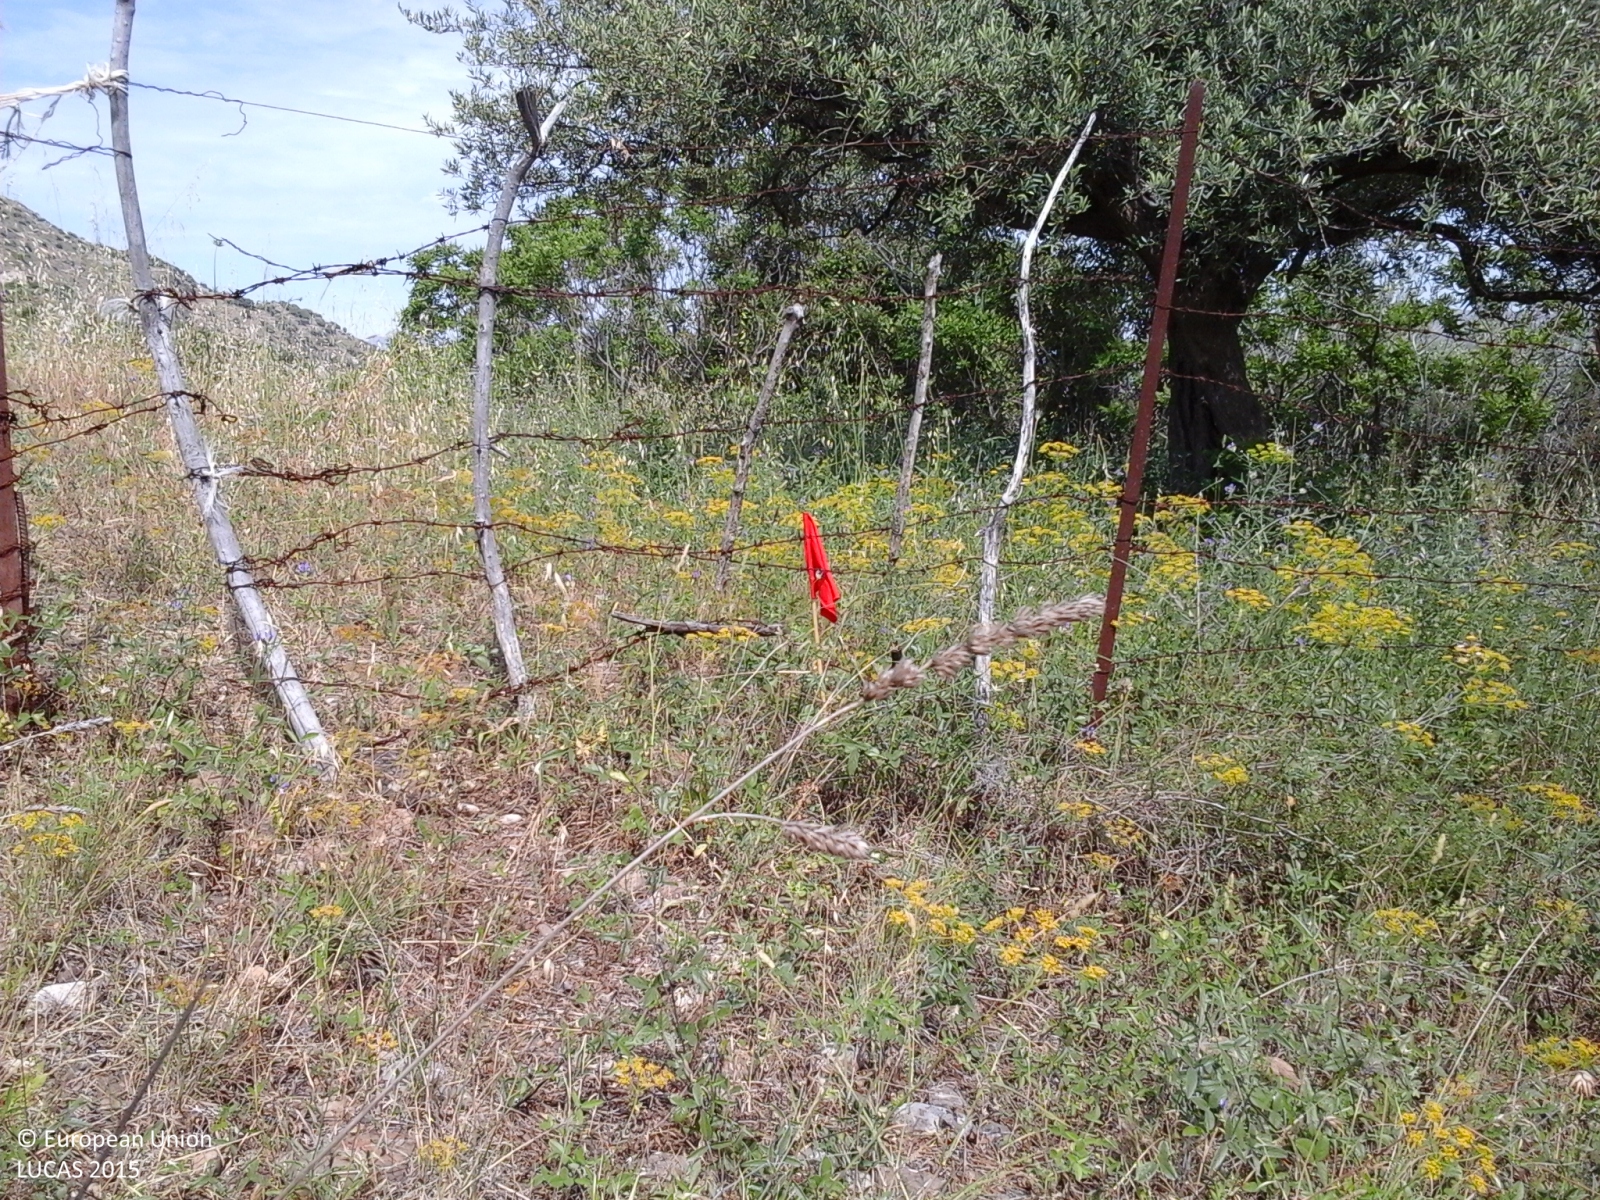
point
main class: Cropland
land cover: Olive groves
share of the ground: 25 - 50 %
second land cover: Spontaneously vegetated surfaces
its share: > 75 %
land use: Agriculture (excluding fallow land and kitchen gardens)
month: May
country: IT
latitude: 37.9163
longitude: 13.5803
